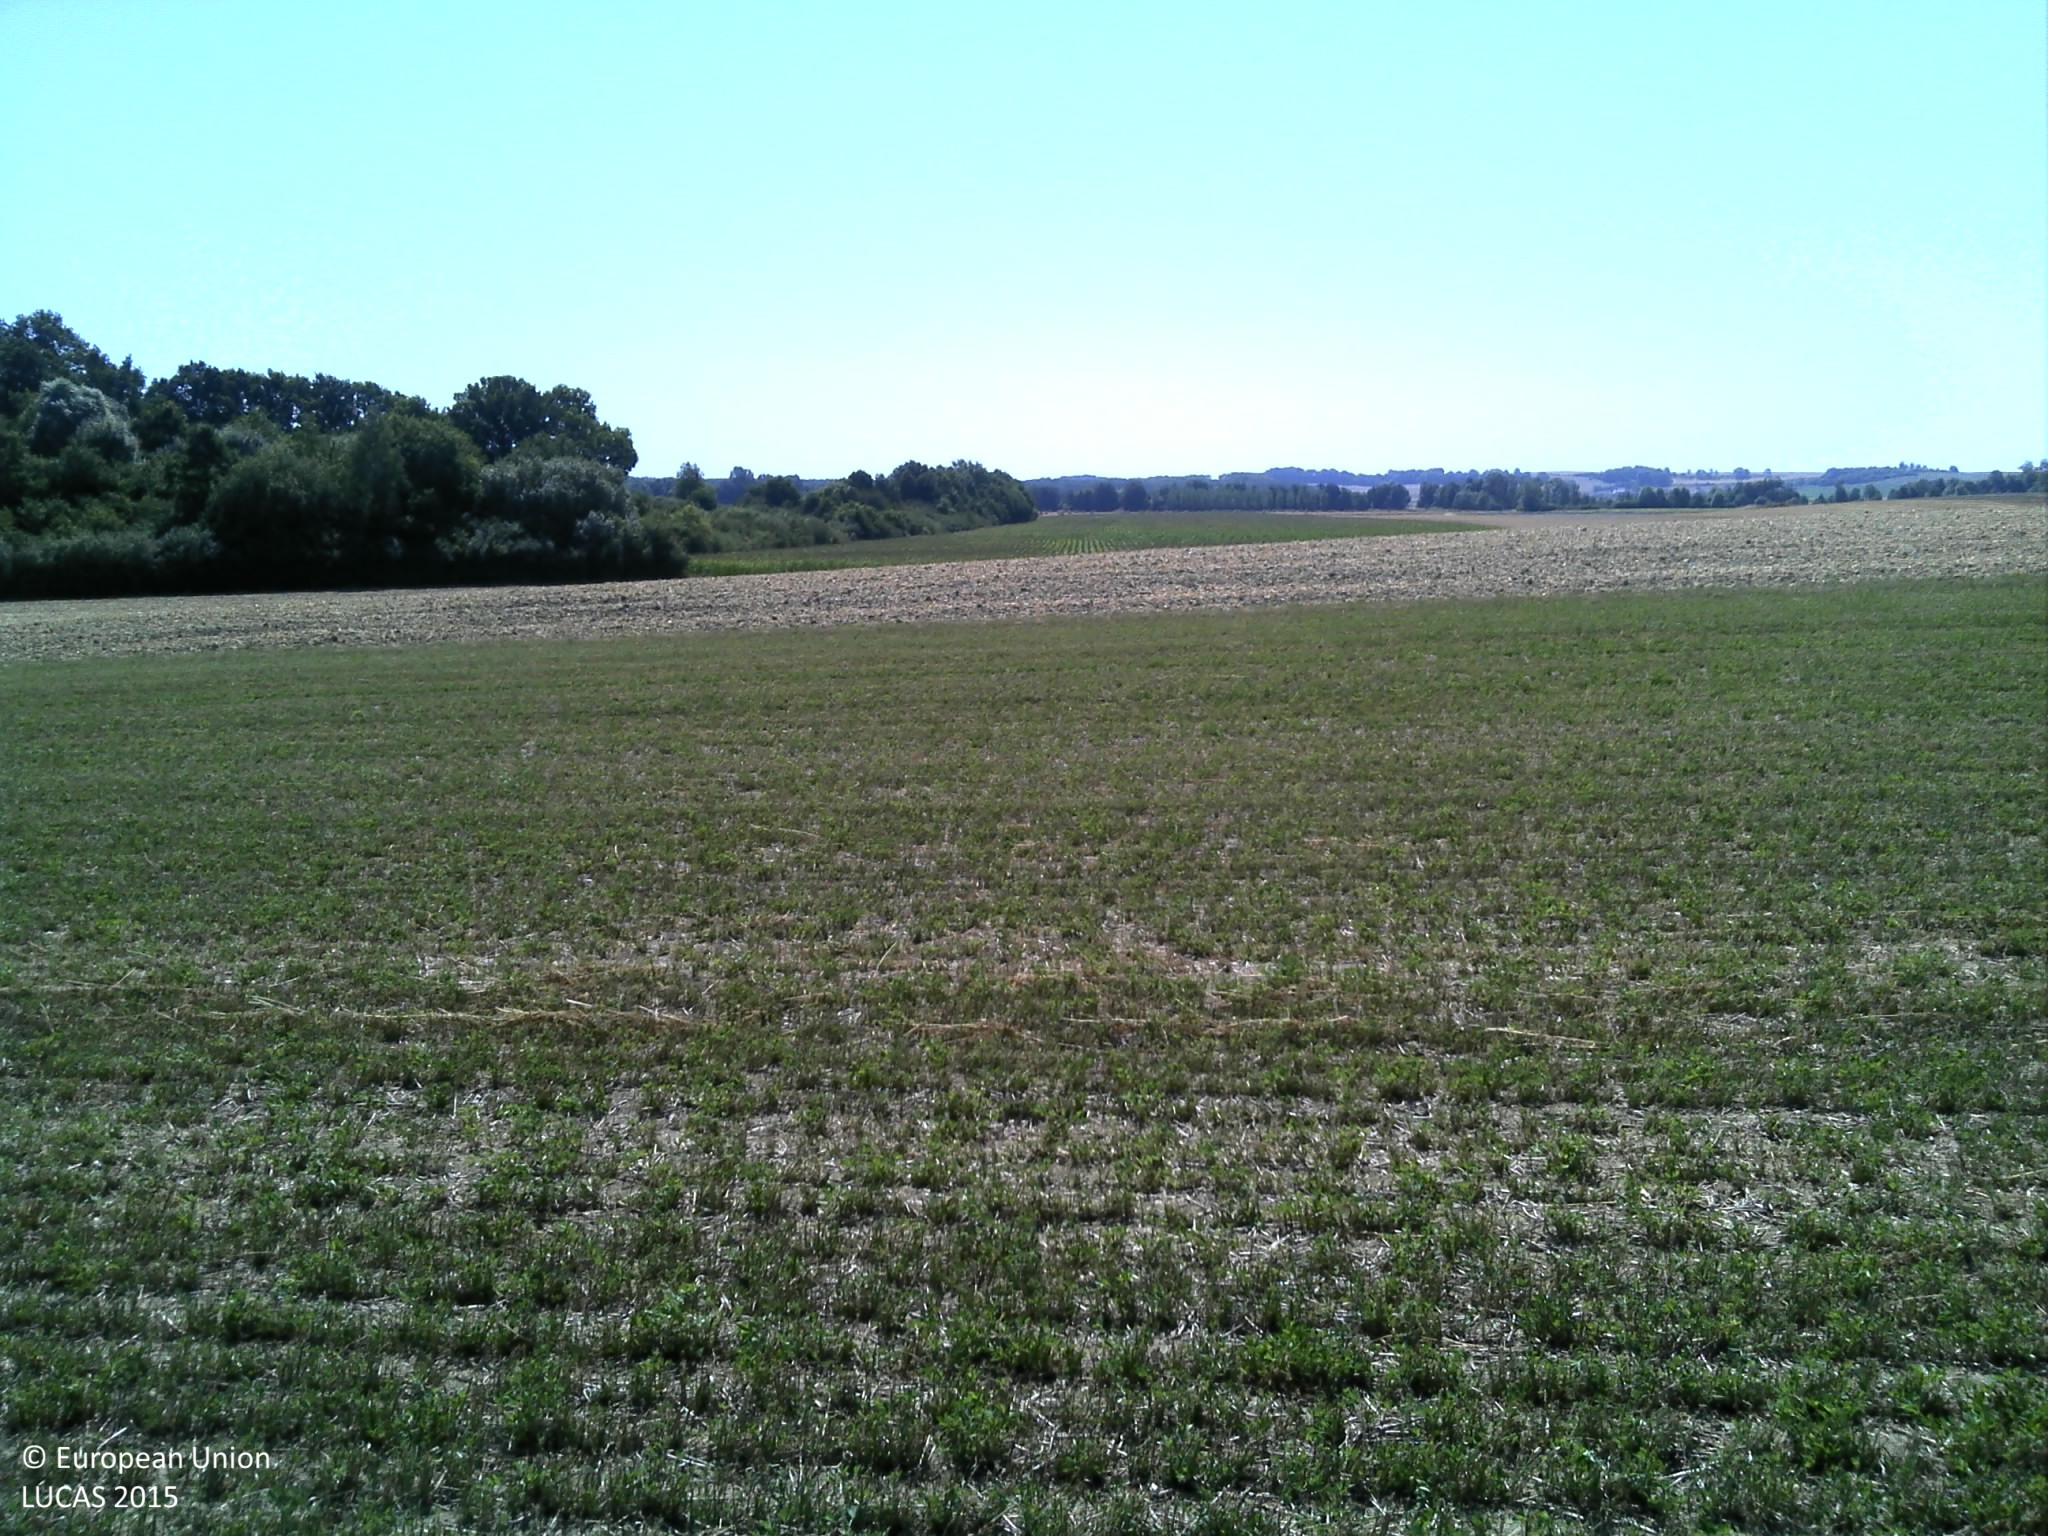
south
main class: Cropland
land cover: Lucerne
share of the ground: > 75 %
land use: Agriculture (excluding fallow land and kitchen gardens)
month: August
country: FR
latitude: 49.2004
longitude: 4.7958
